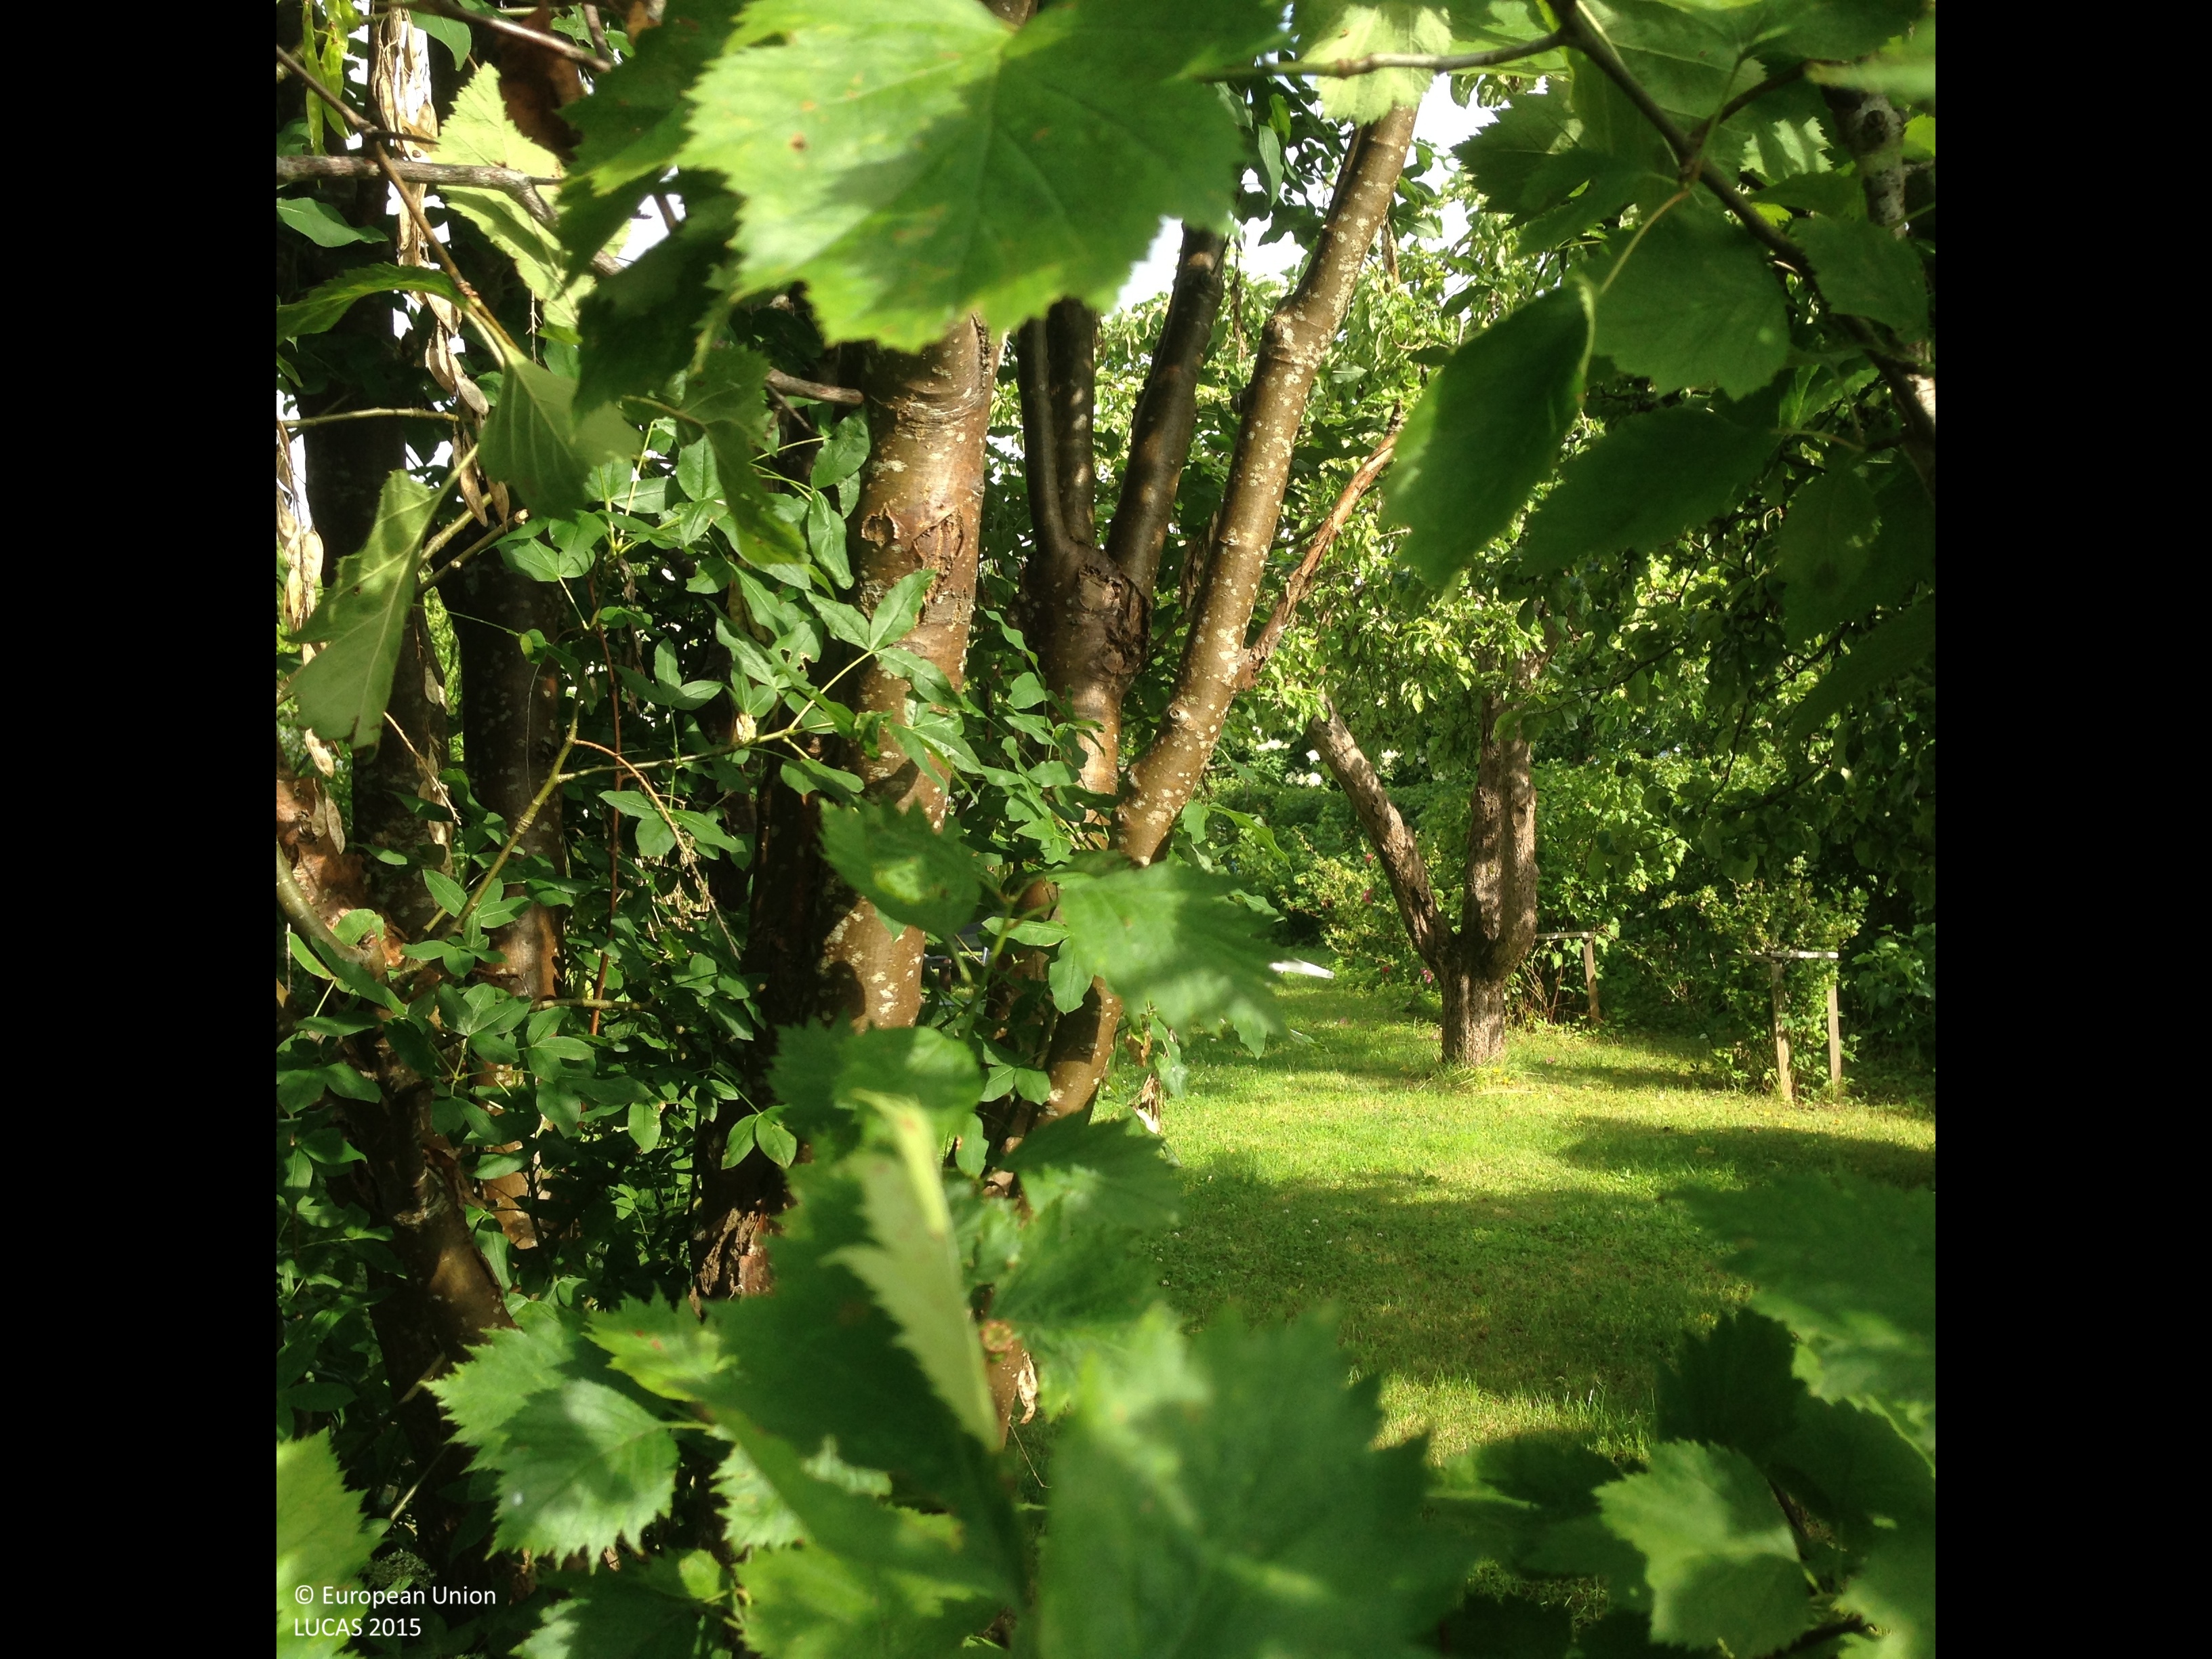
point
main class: Cropland
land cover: Apple fruit
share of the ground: > 75 %
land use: Kitchen garden
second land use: Amenities, museums, leisure
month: July
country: SE
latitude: 59.8481
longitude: 17.6156
